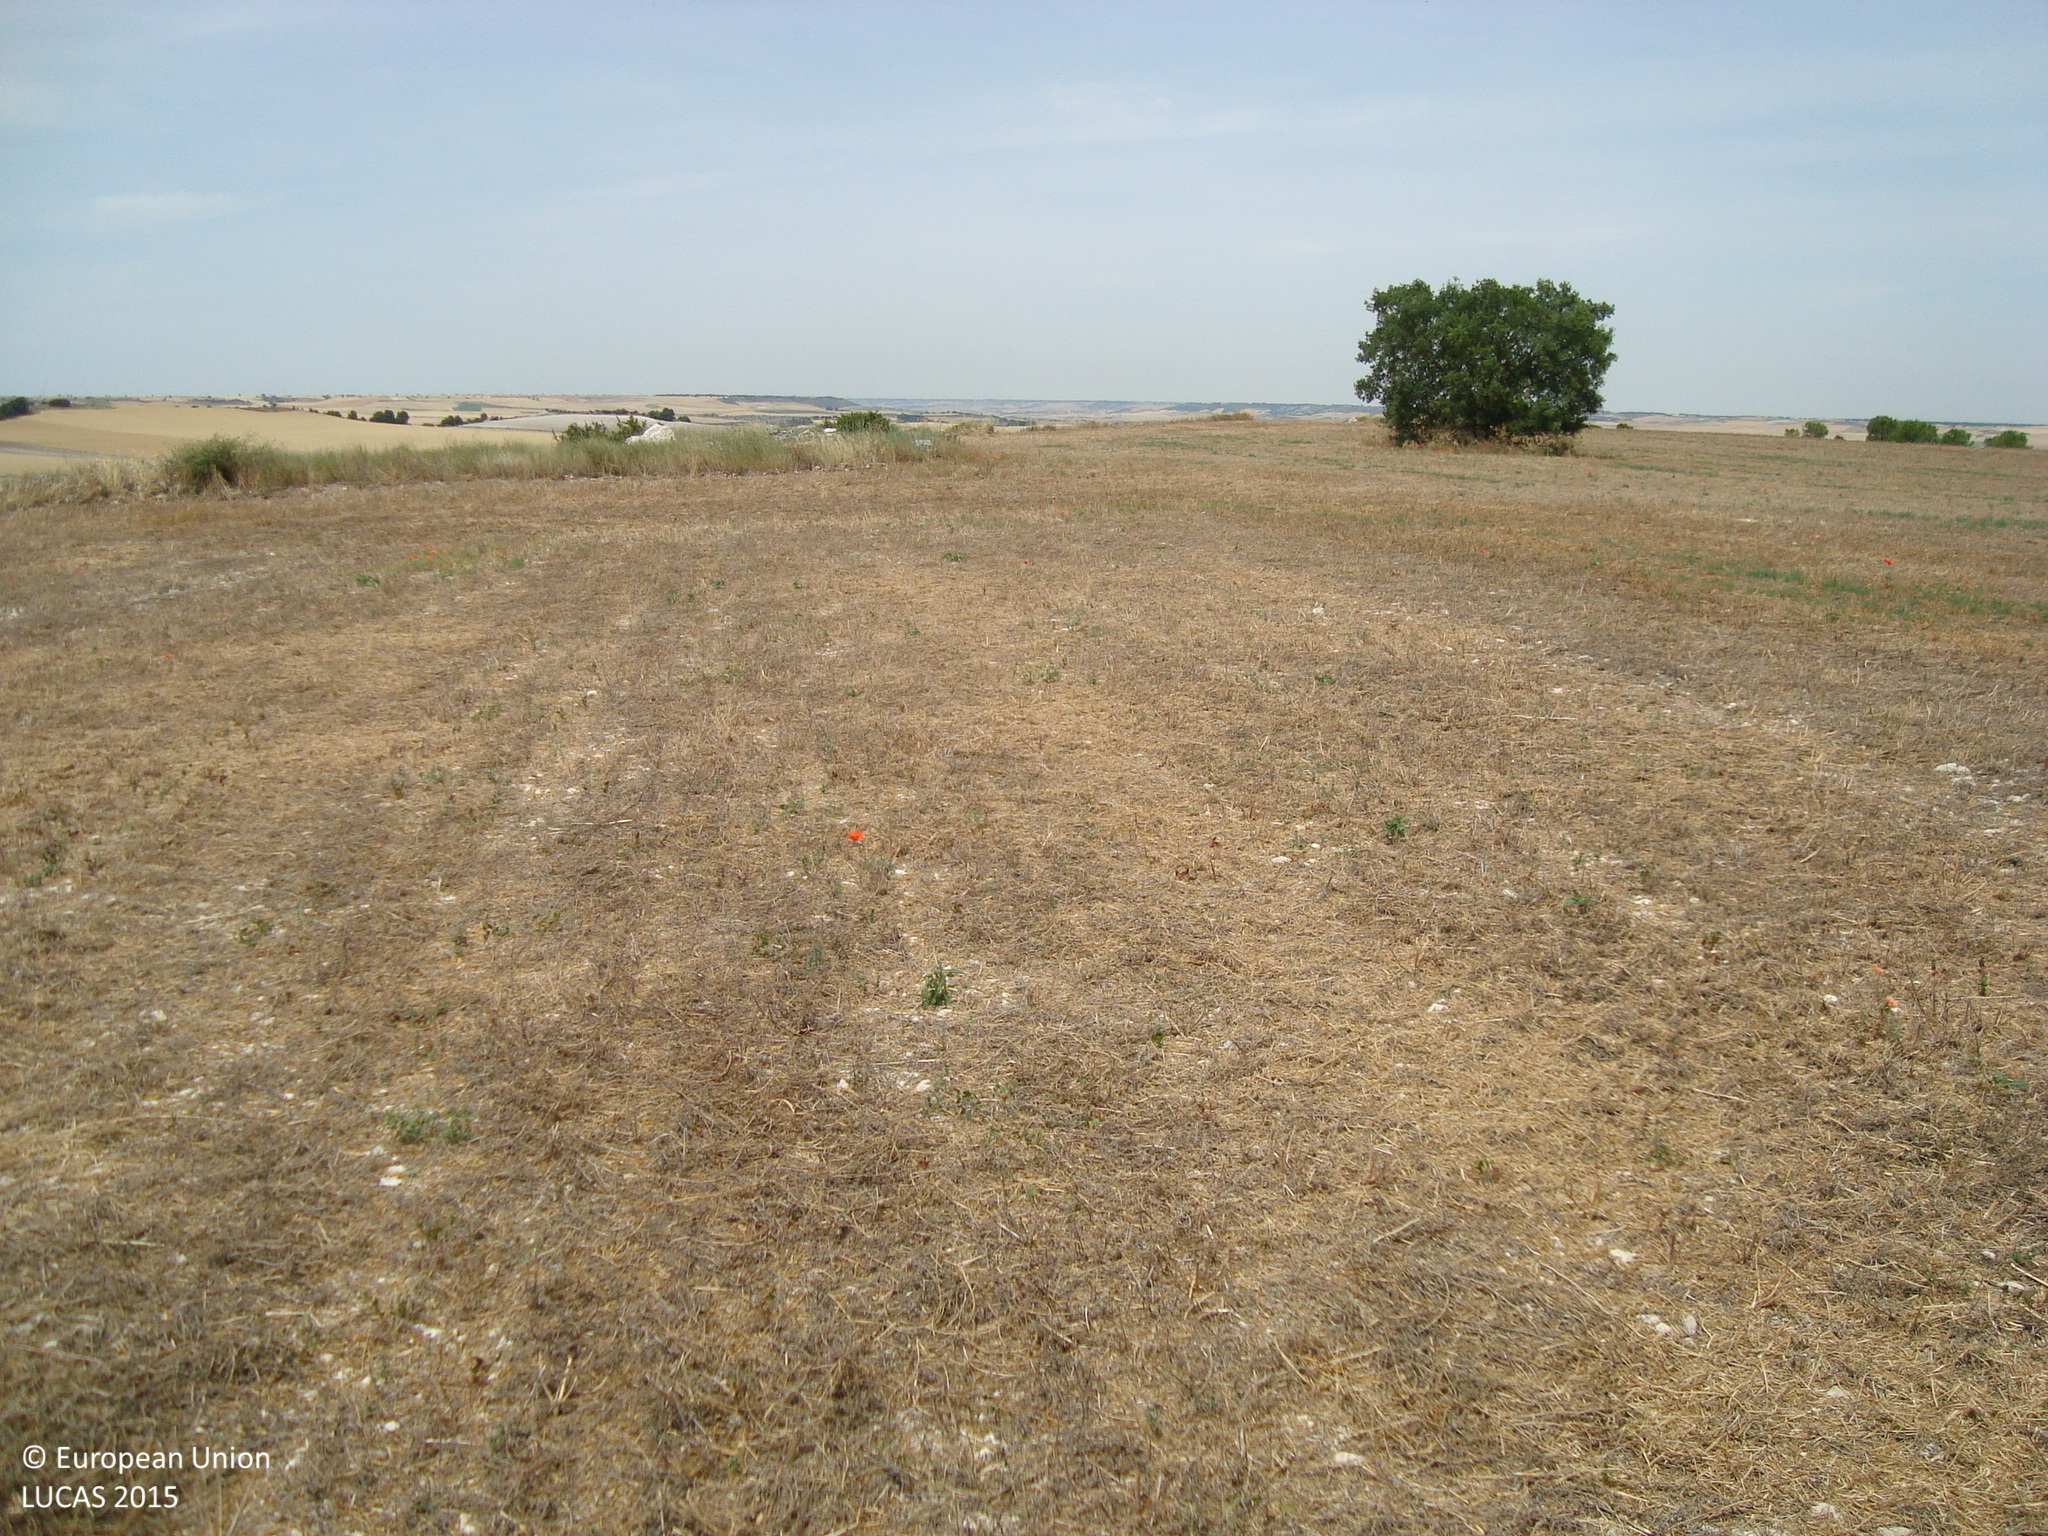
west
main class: Cropland
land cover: Dry pulses
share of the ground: < 10 %
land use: Agriculture (excluding fallow land and kitchen gardens)
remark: Harvested field
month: July
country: ES
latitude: 41.7408
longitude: -4.1896
